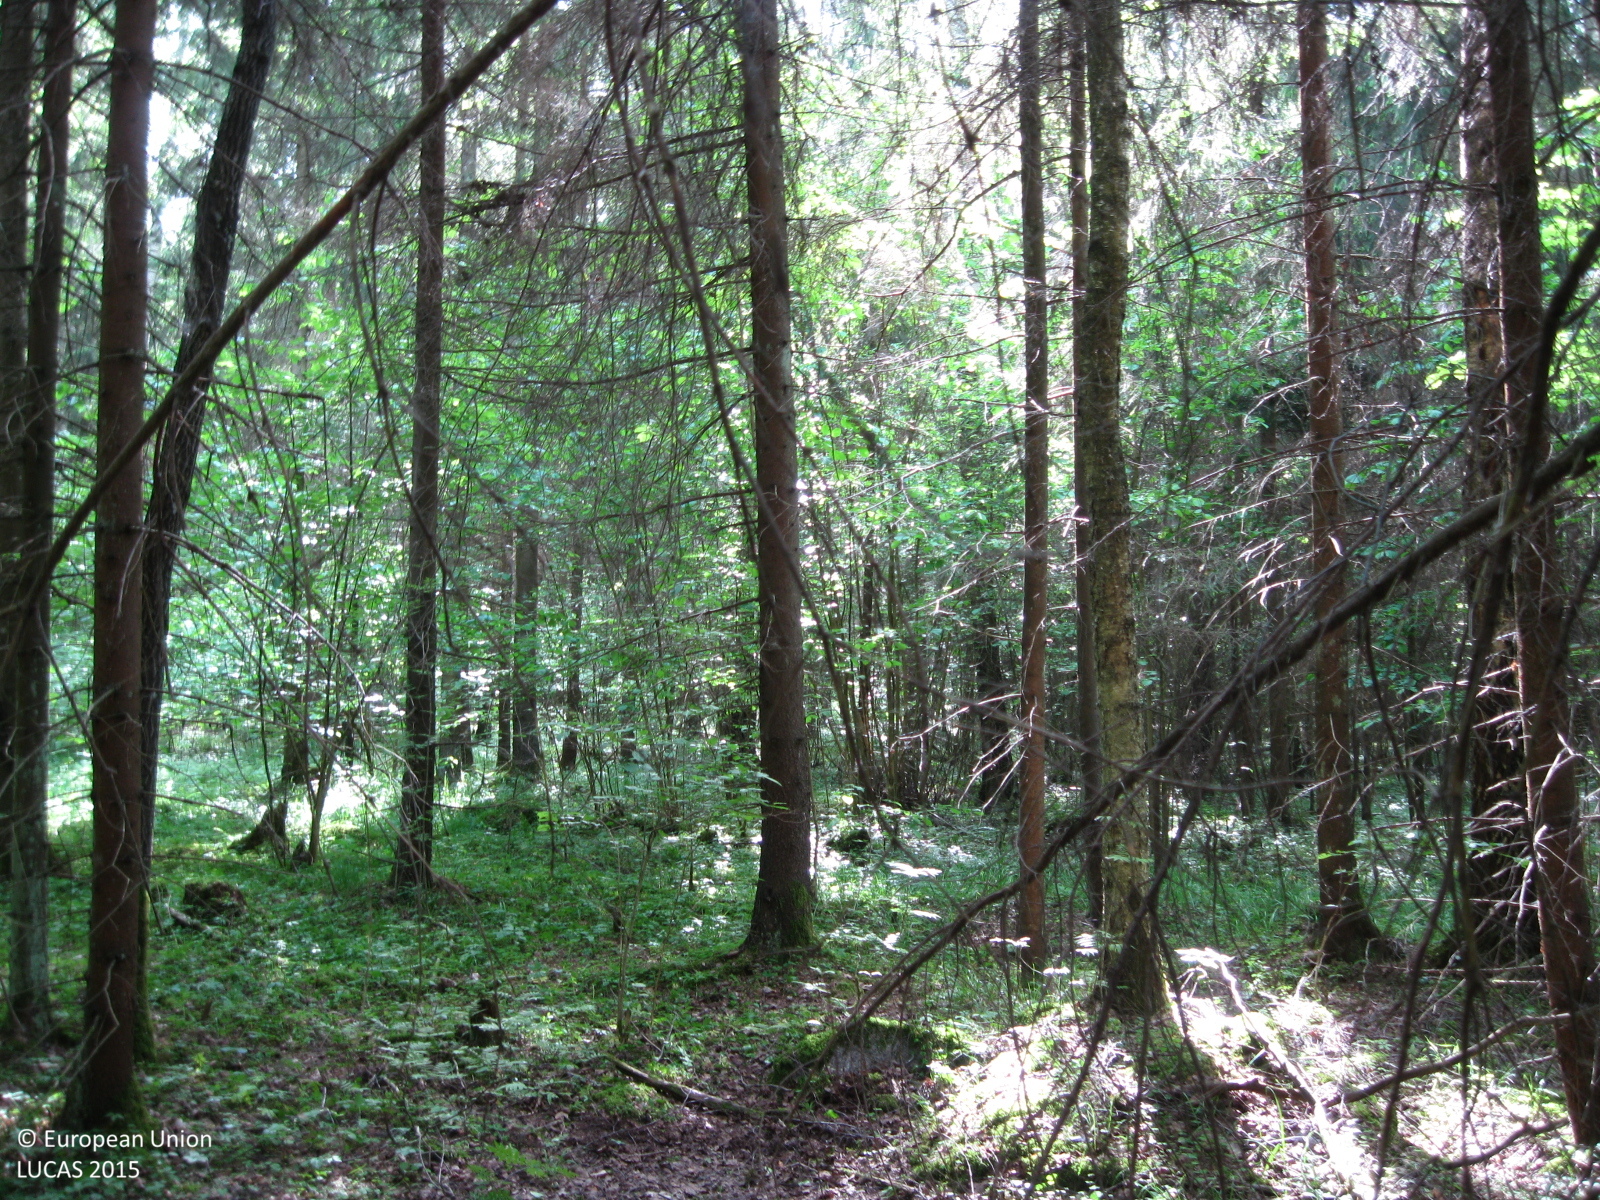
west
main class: Woodland
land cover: Spruce dominated mixed woodland
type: hemiboreal forest and nemoral coniferous forest and mixed broadleaved-coniferous forest
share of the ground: > 75 %
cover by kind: coniferous forest trees 65 %, broadleaved forest trees 25 %, unconsolidated bare surface 10 %
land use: Forestry
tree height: > 5 m
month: June
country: LT
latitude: 55.6030
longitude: 23.6200
